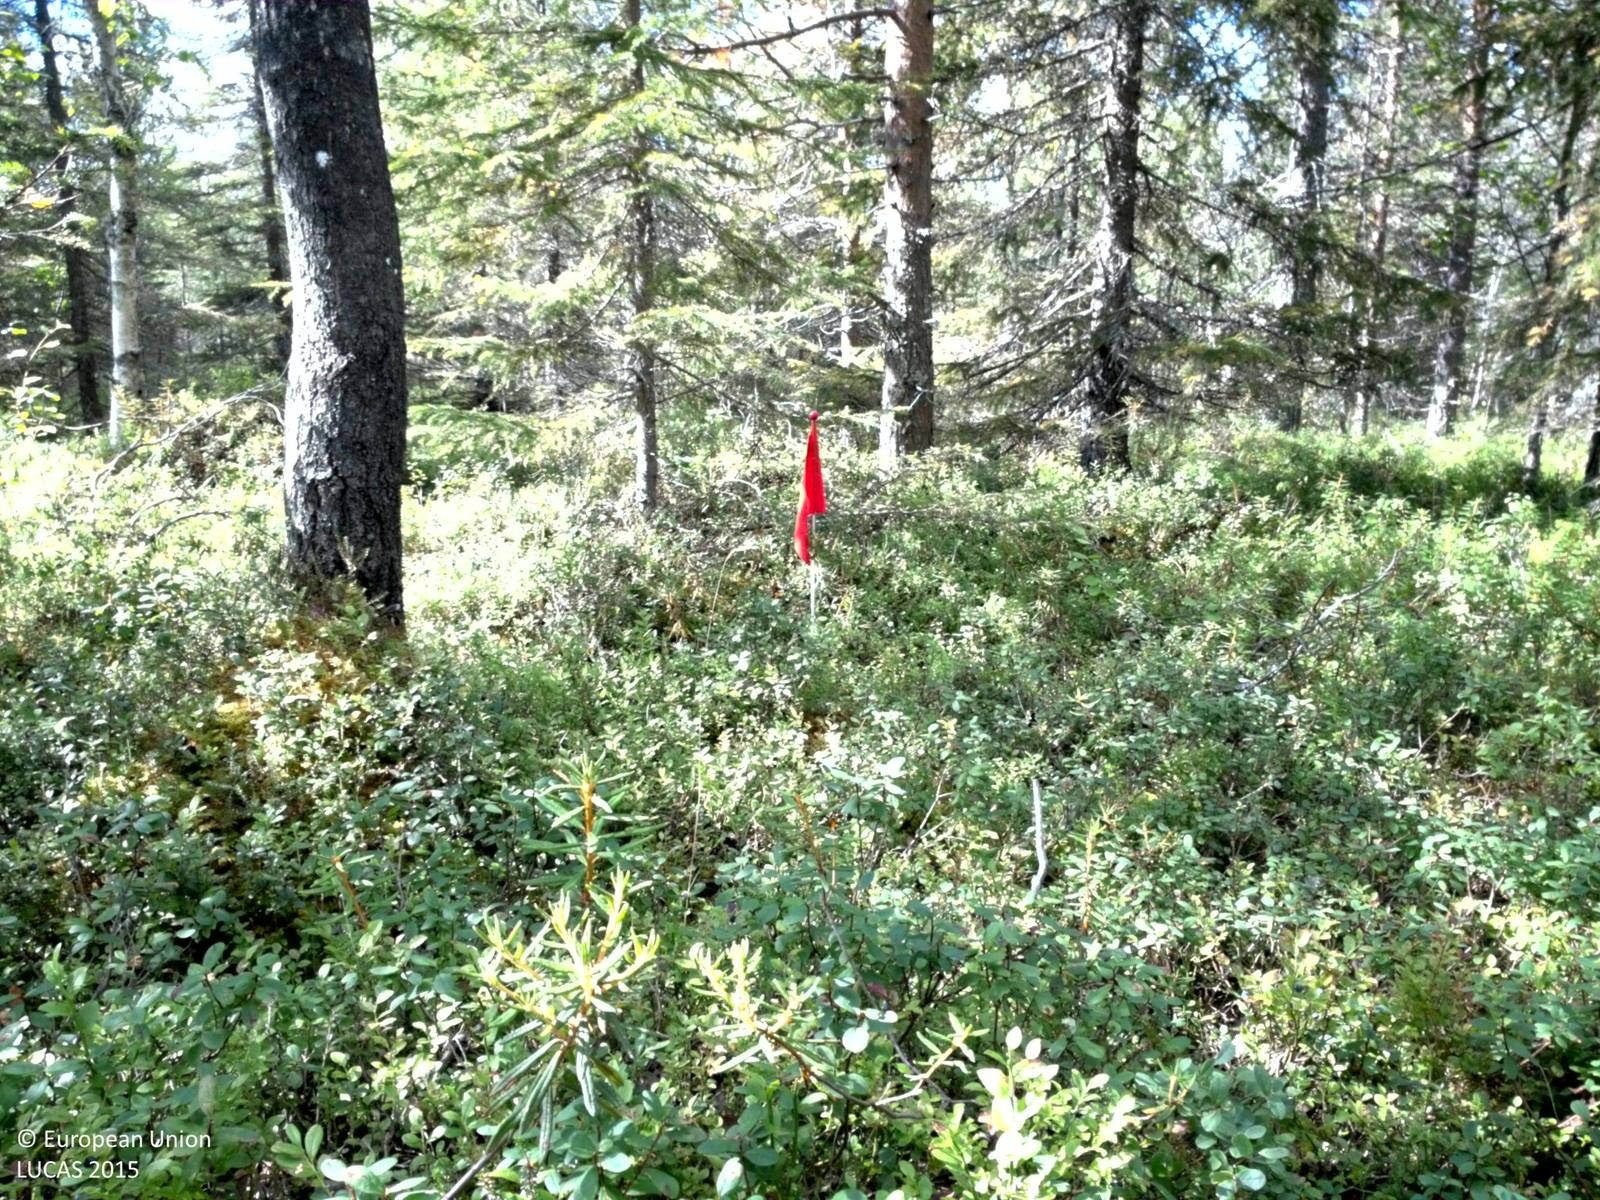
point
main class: Woodland
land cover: Pine dominated coniferous woodland
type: boreal forest
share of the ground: 25 - 50 %
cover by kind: shrubs 65 %, coniferous forest trees 30 %, broadleaved forest trees 5 %
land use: Forestry
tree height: > 5 m
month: August
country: SE
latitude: 66.1716
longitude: 22.3298
